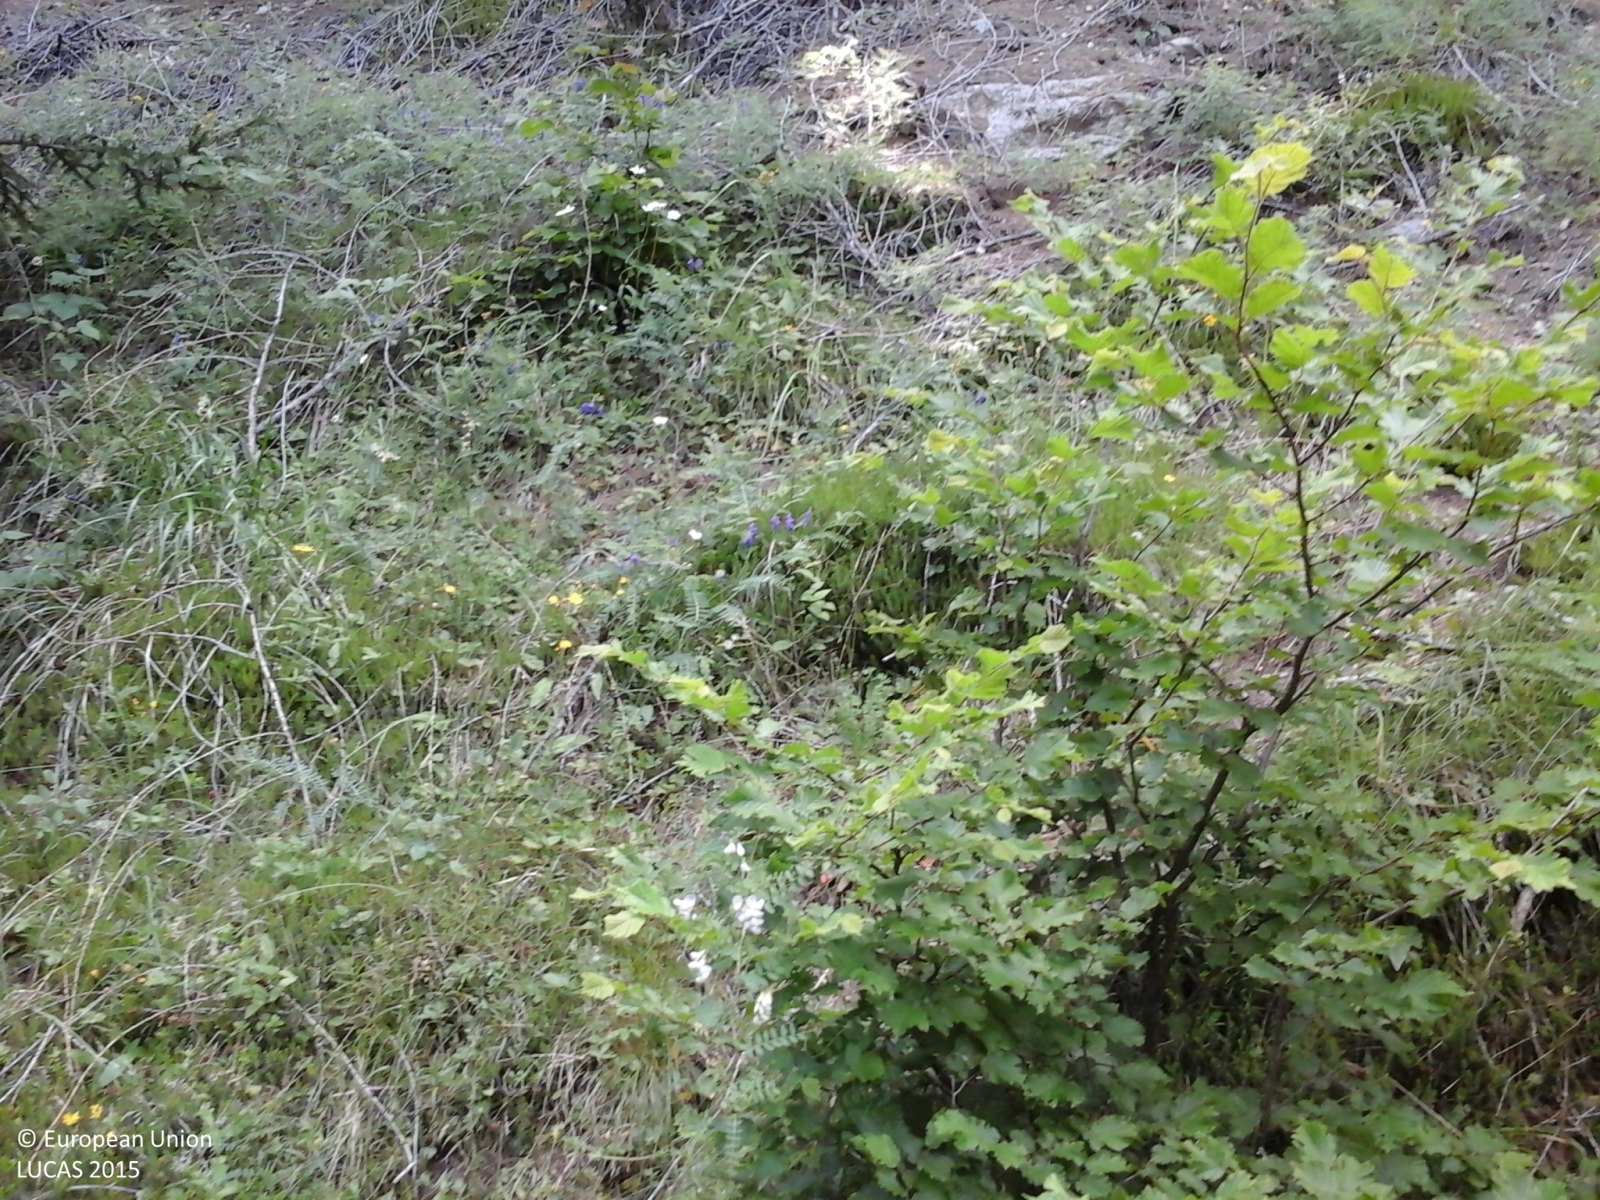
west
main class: Woodland
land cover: Spruce dominated coniferous woodland
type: alpine coniferous forest
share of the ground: > 75 %
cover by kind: coniferous forest trees 100 %
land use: Forestry
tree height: > 5 m
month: June
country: IT
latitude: 46.7534
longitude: 11.6085
